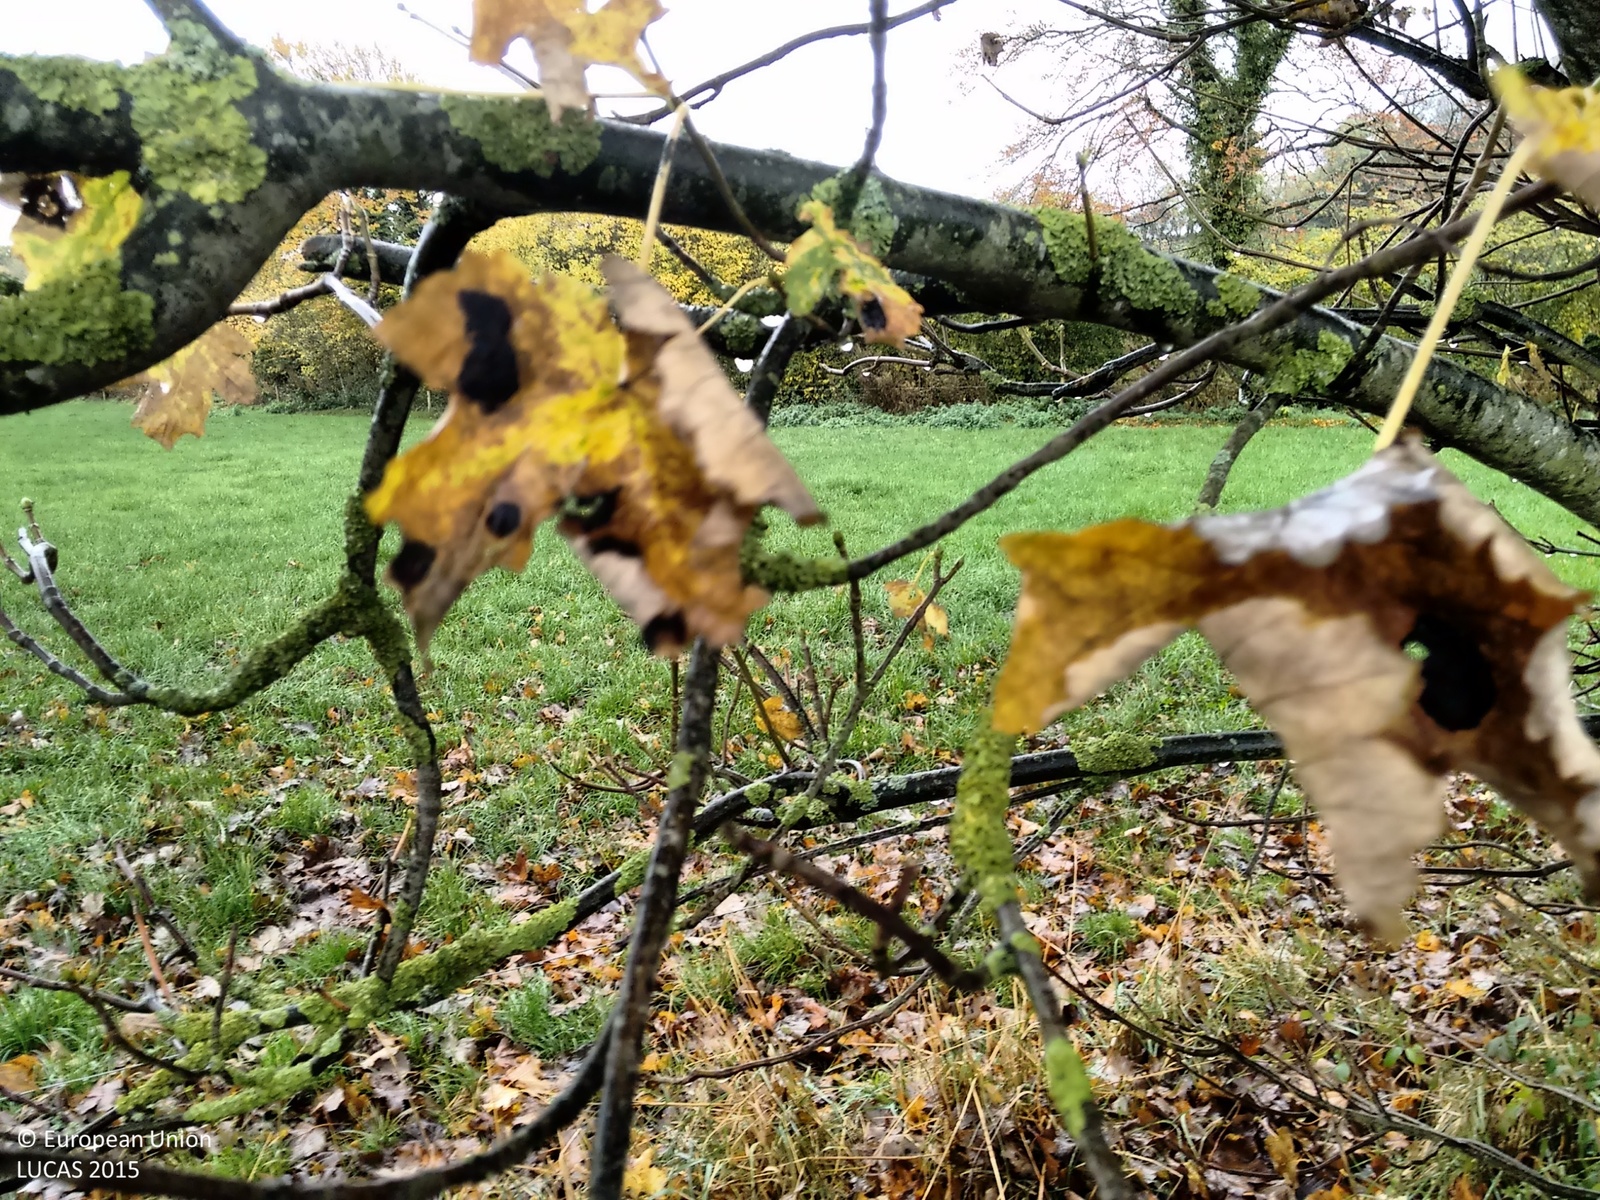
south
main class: Grassland
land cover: Grassland without tree/shrub cover
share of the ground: > 75 %
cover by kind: herbaceous plants 100 %
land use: Agriculture (excluding fallow land and kitchen gardens)
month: October
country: IE
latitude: 52.8862
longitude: -7.5022
